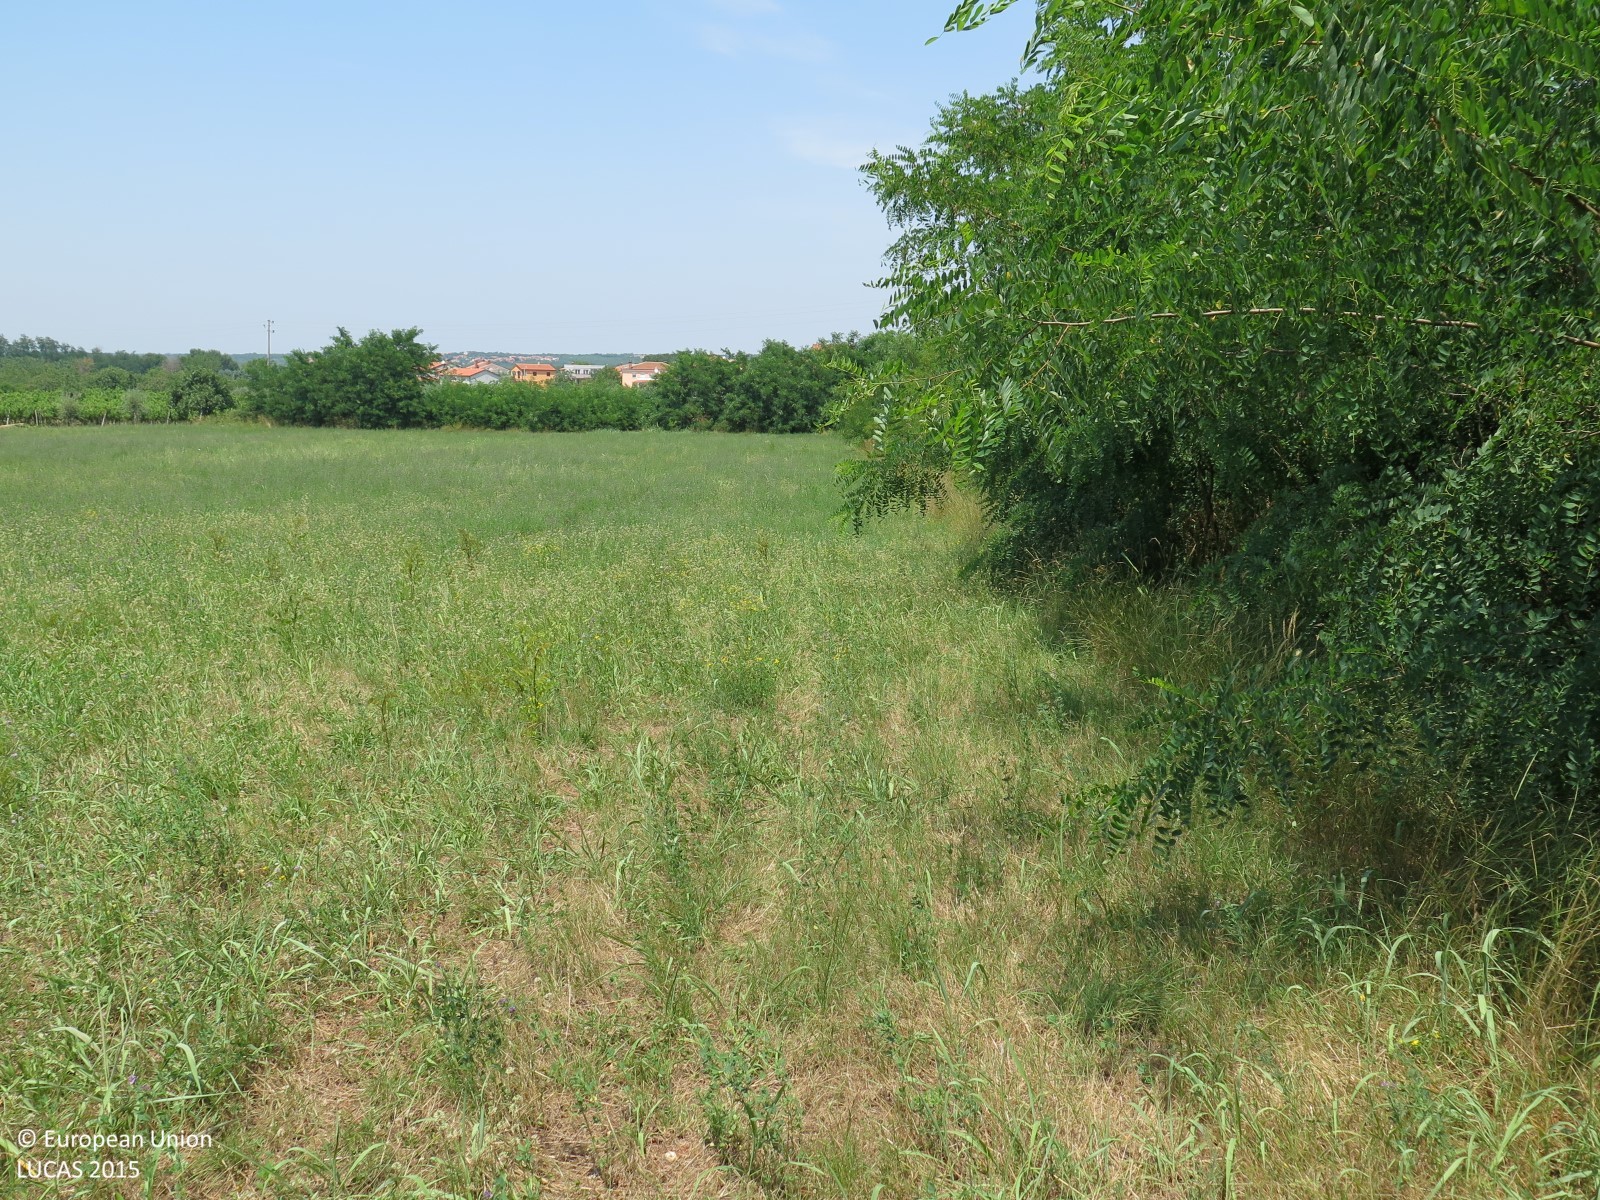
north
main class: Cropland
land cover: Temporary grasslands
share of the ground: > 75 %
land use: Agriculture (excluding fallow land and kitchen gardens)
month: July
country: HR
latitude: 45.4075
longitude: 13.5855
